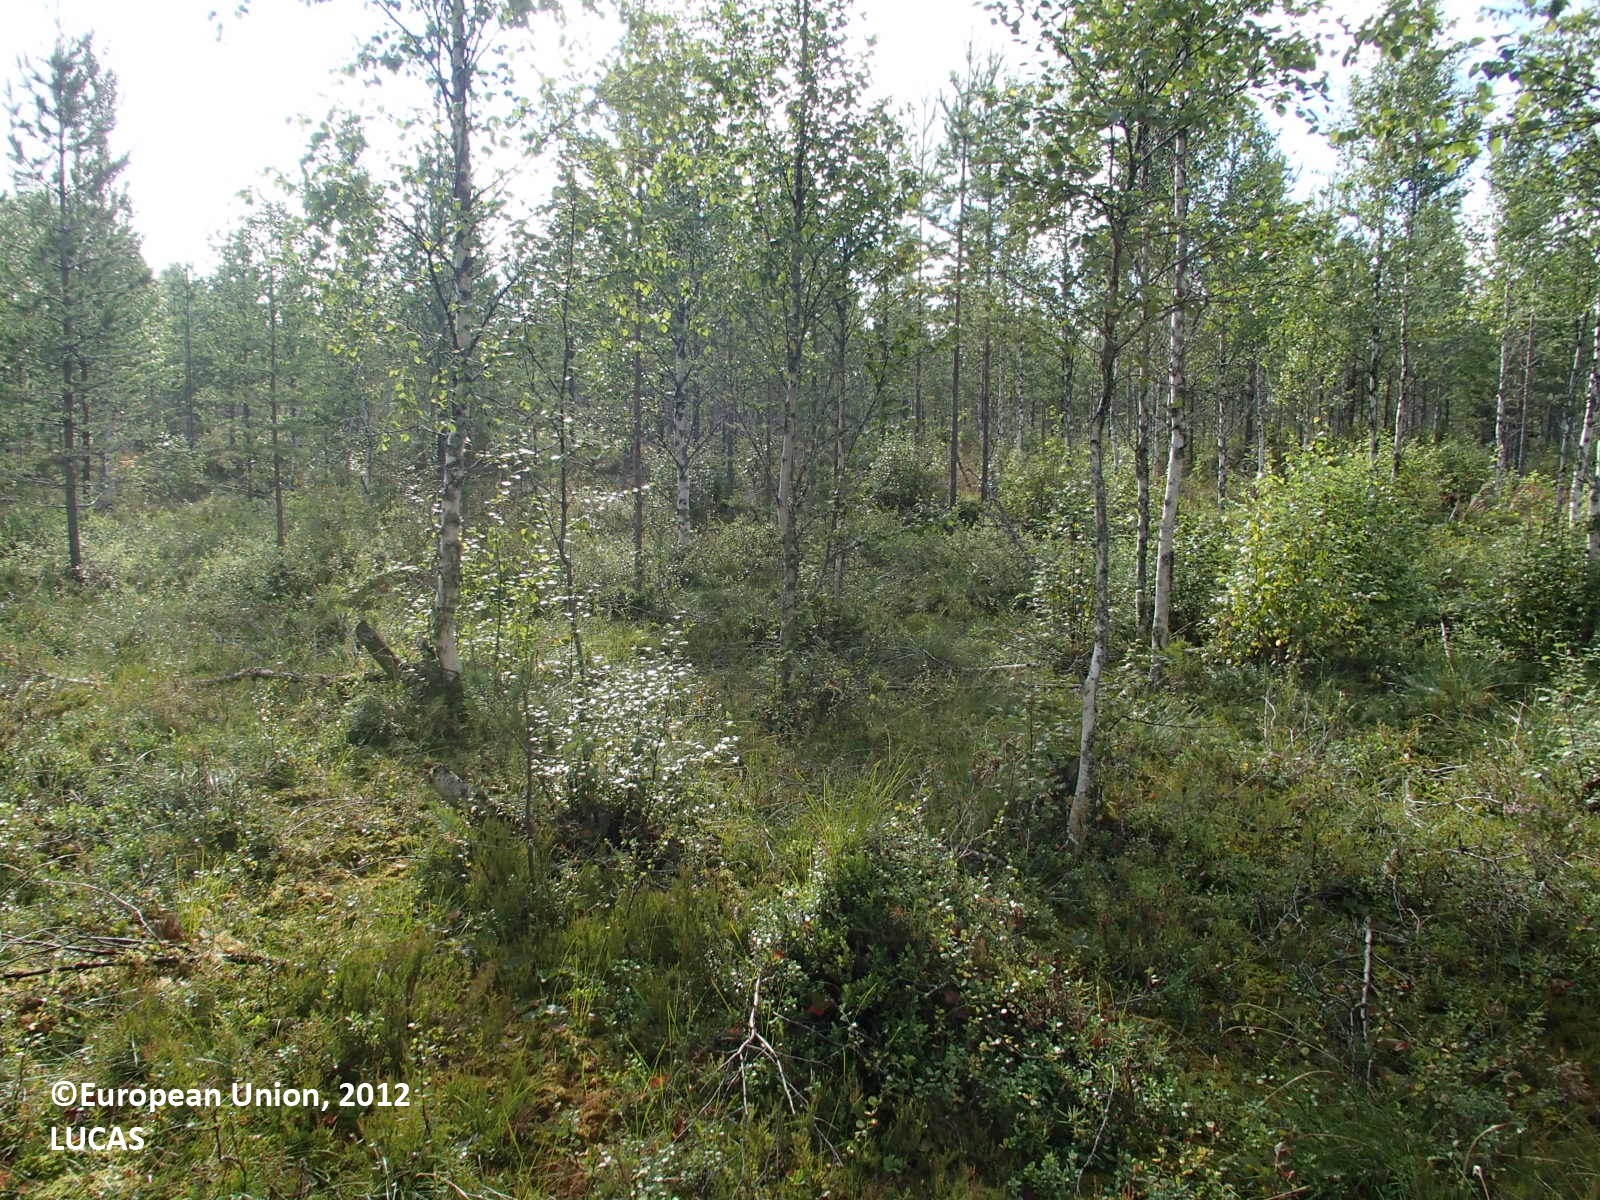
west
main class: Woodland
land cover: Pine dominated mixed woodland
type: boreal forest
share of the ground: 25 - 50 %
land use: Forestry
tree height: > 5 m
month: August
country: FI
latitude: 63.8384
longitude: 28.1641
